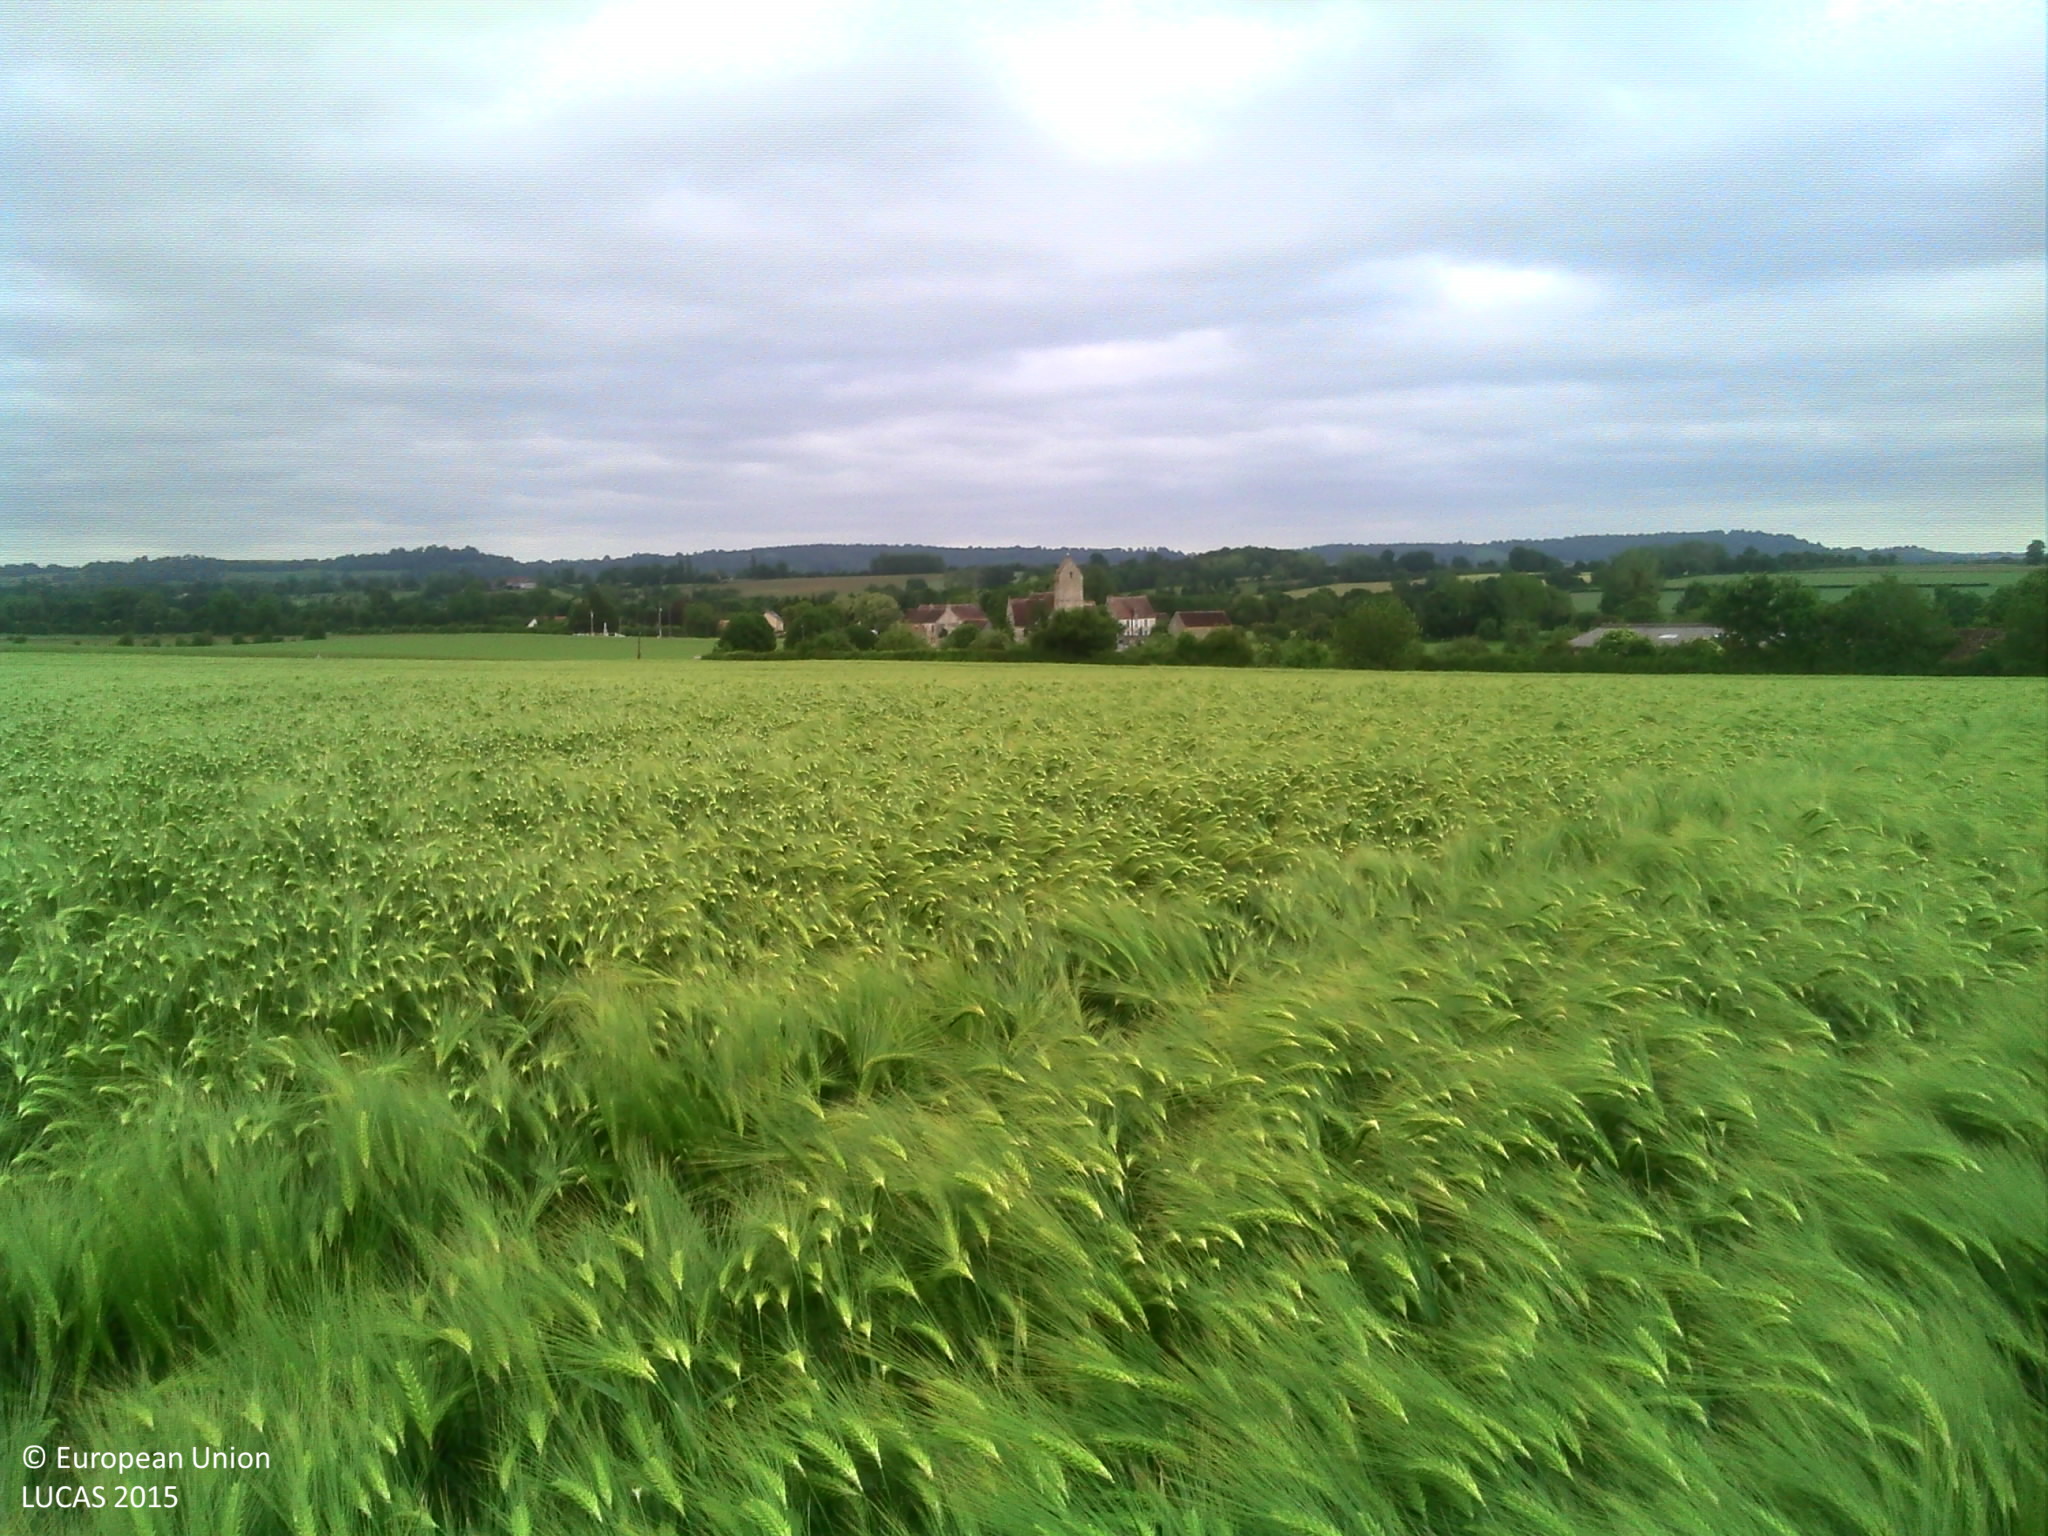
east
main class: Cropland
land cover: Barley
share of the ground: > 75 %
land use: Agriculture (excluding fallow land and kitchen gardens)
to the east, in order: Barley; Grass margins; Paved roads, cycling and walking lanes; Grass margins; Managed hedges; Electric lines; Grassland with sparse tree/shrub cover
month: June
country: FR
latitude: 48.8431
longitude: 0.0641
